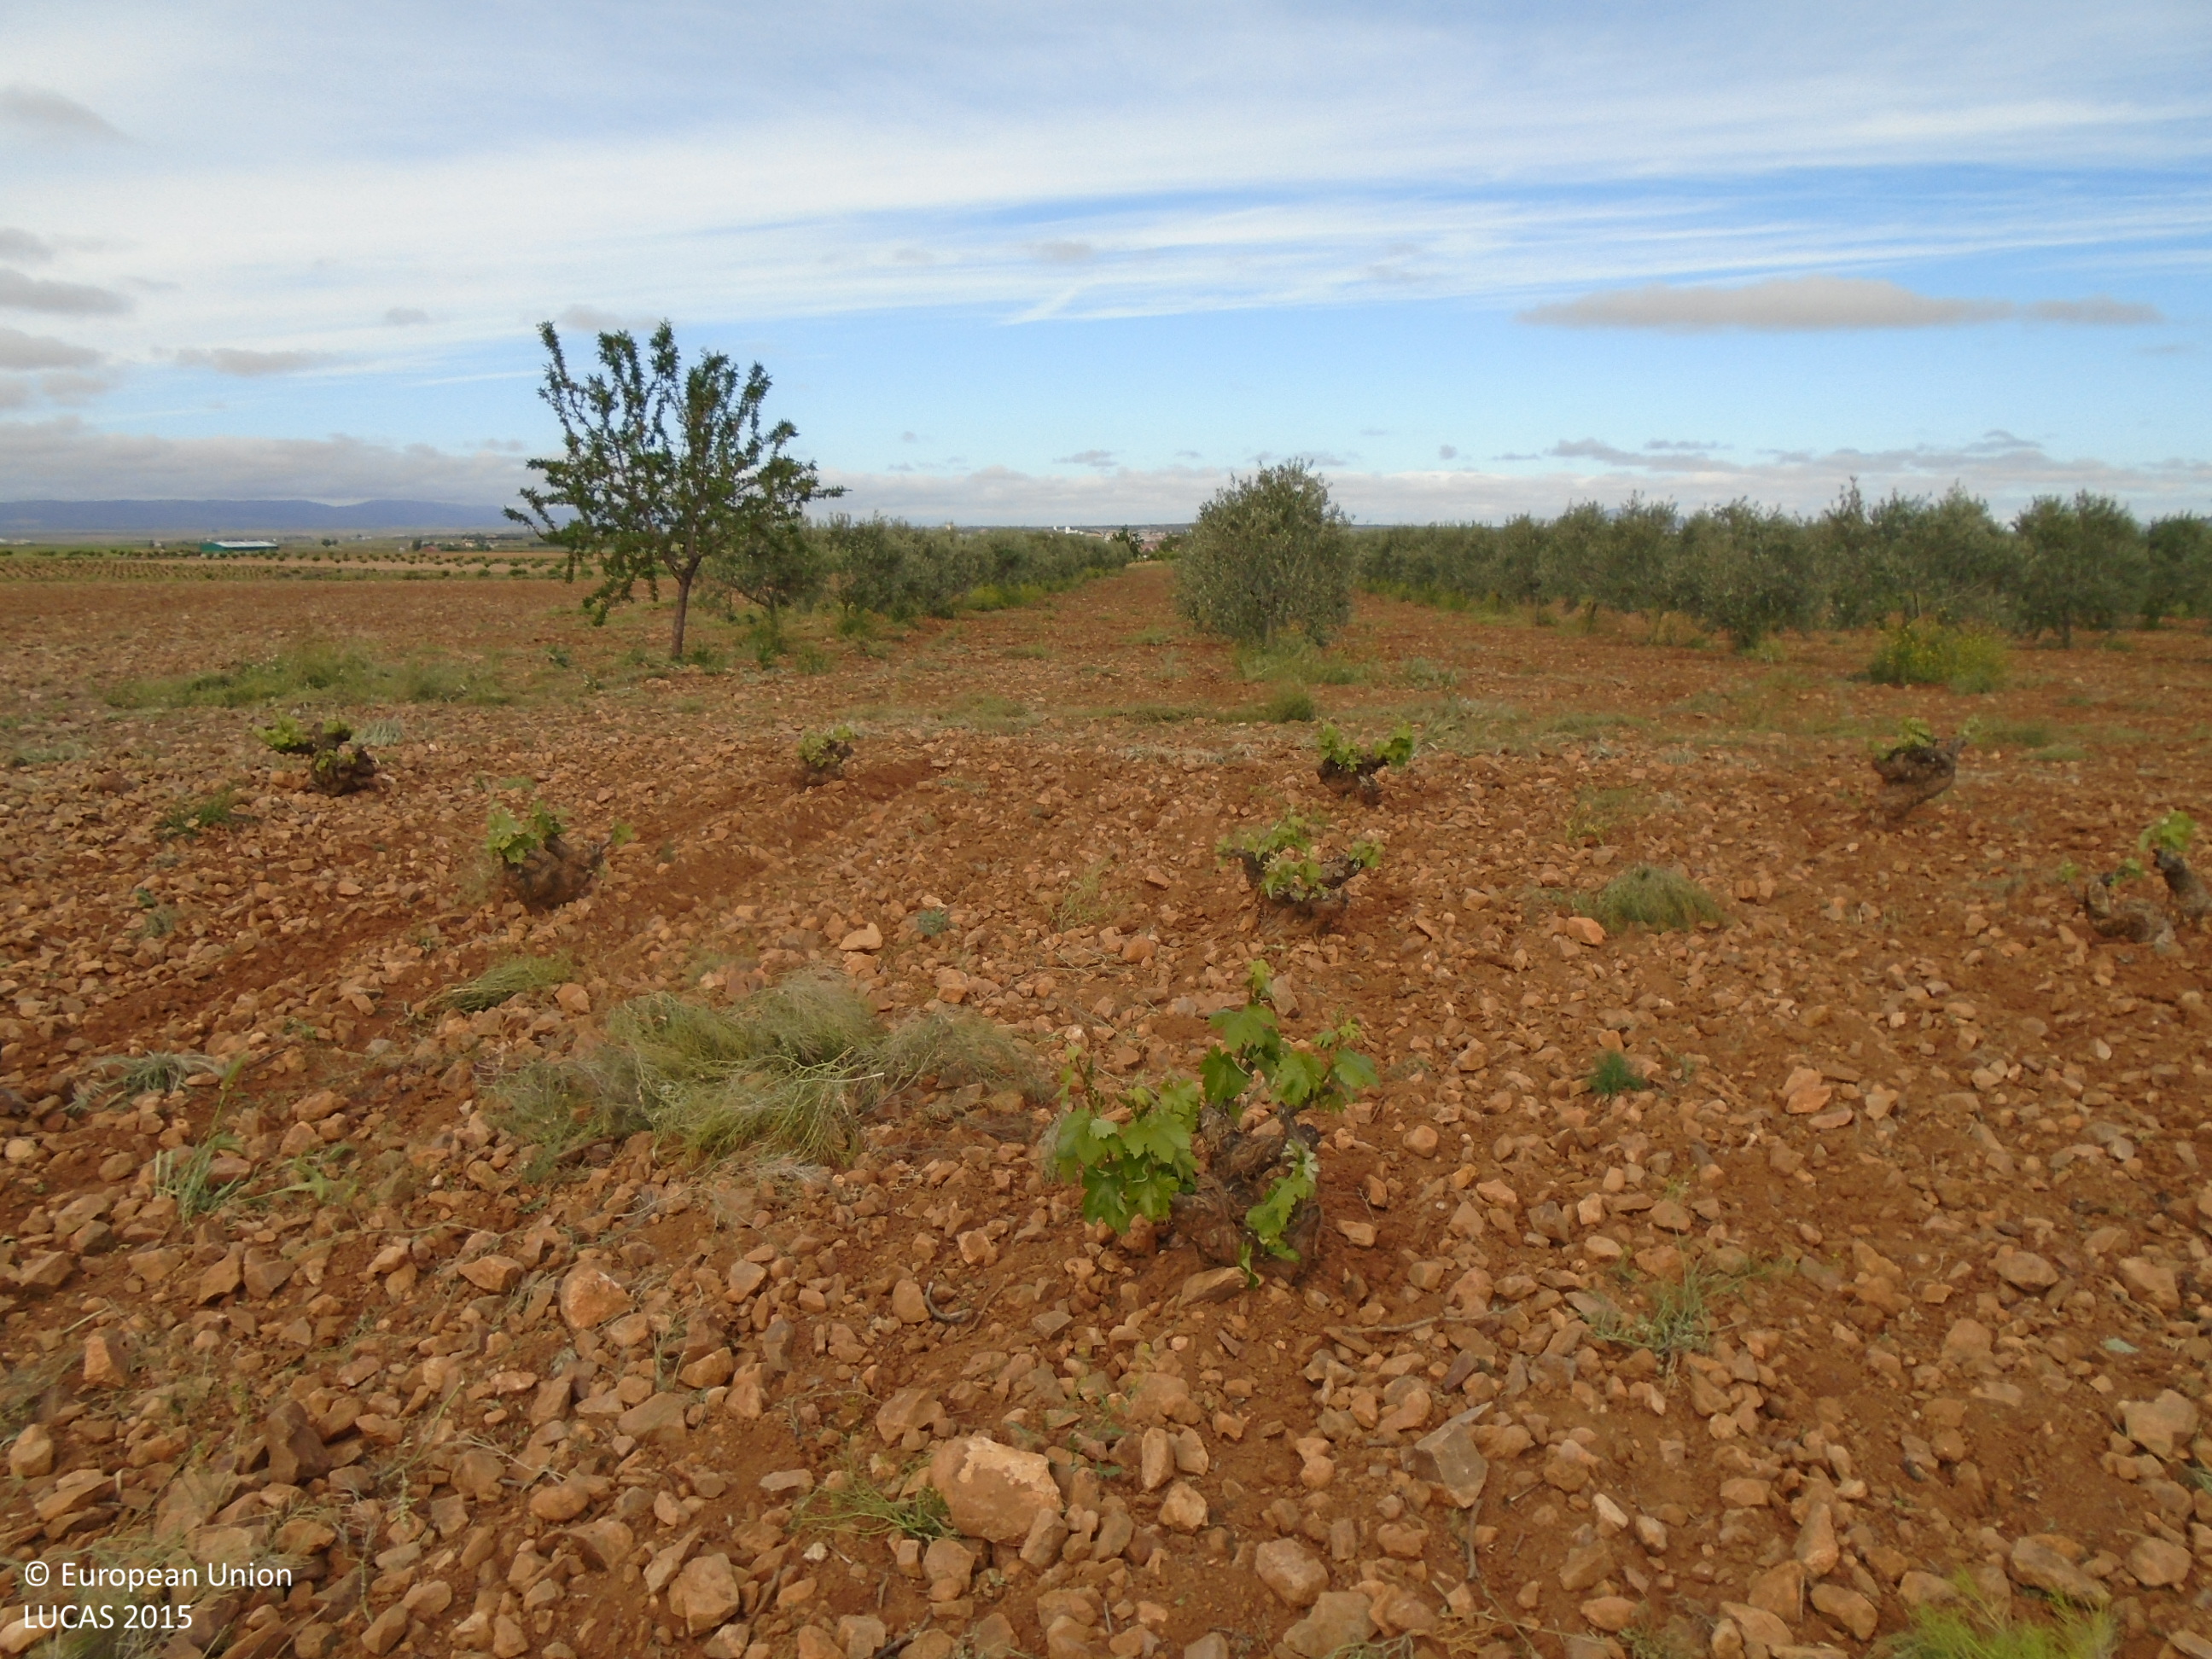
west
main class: Cropland
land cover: Vineyards
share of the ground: 10 - 25 %
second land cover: Other bare soil
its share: > 75 %
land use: Agriculture (excluding fallow land and kitchen gardens)
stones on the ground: > 50 %
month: May
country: ES
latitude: 39.6788
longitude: -3.7507
